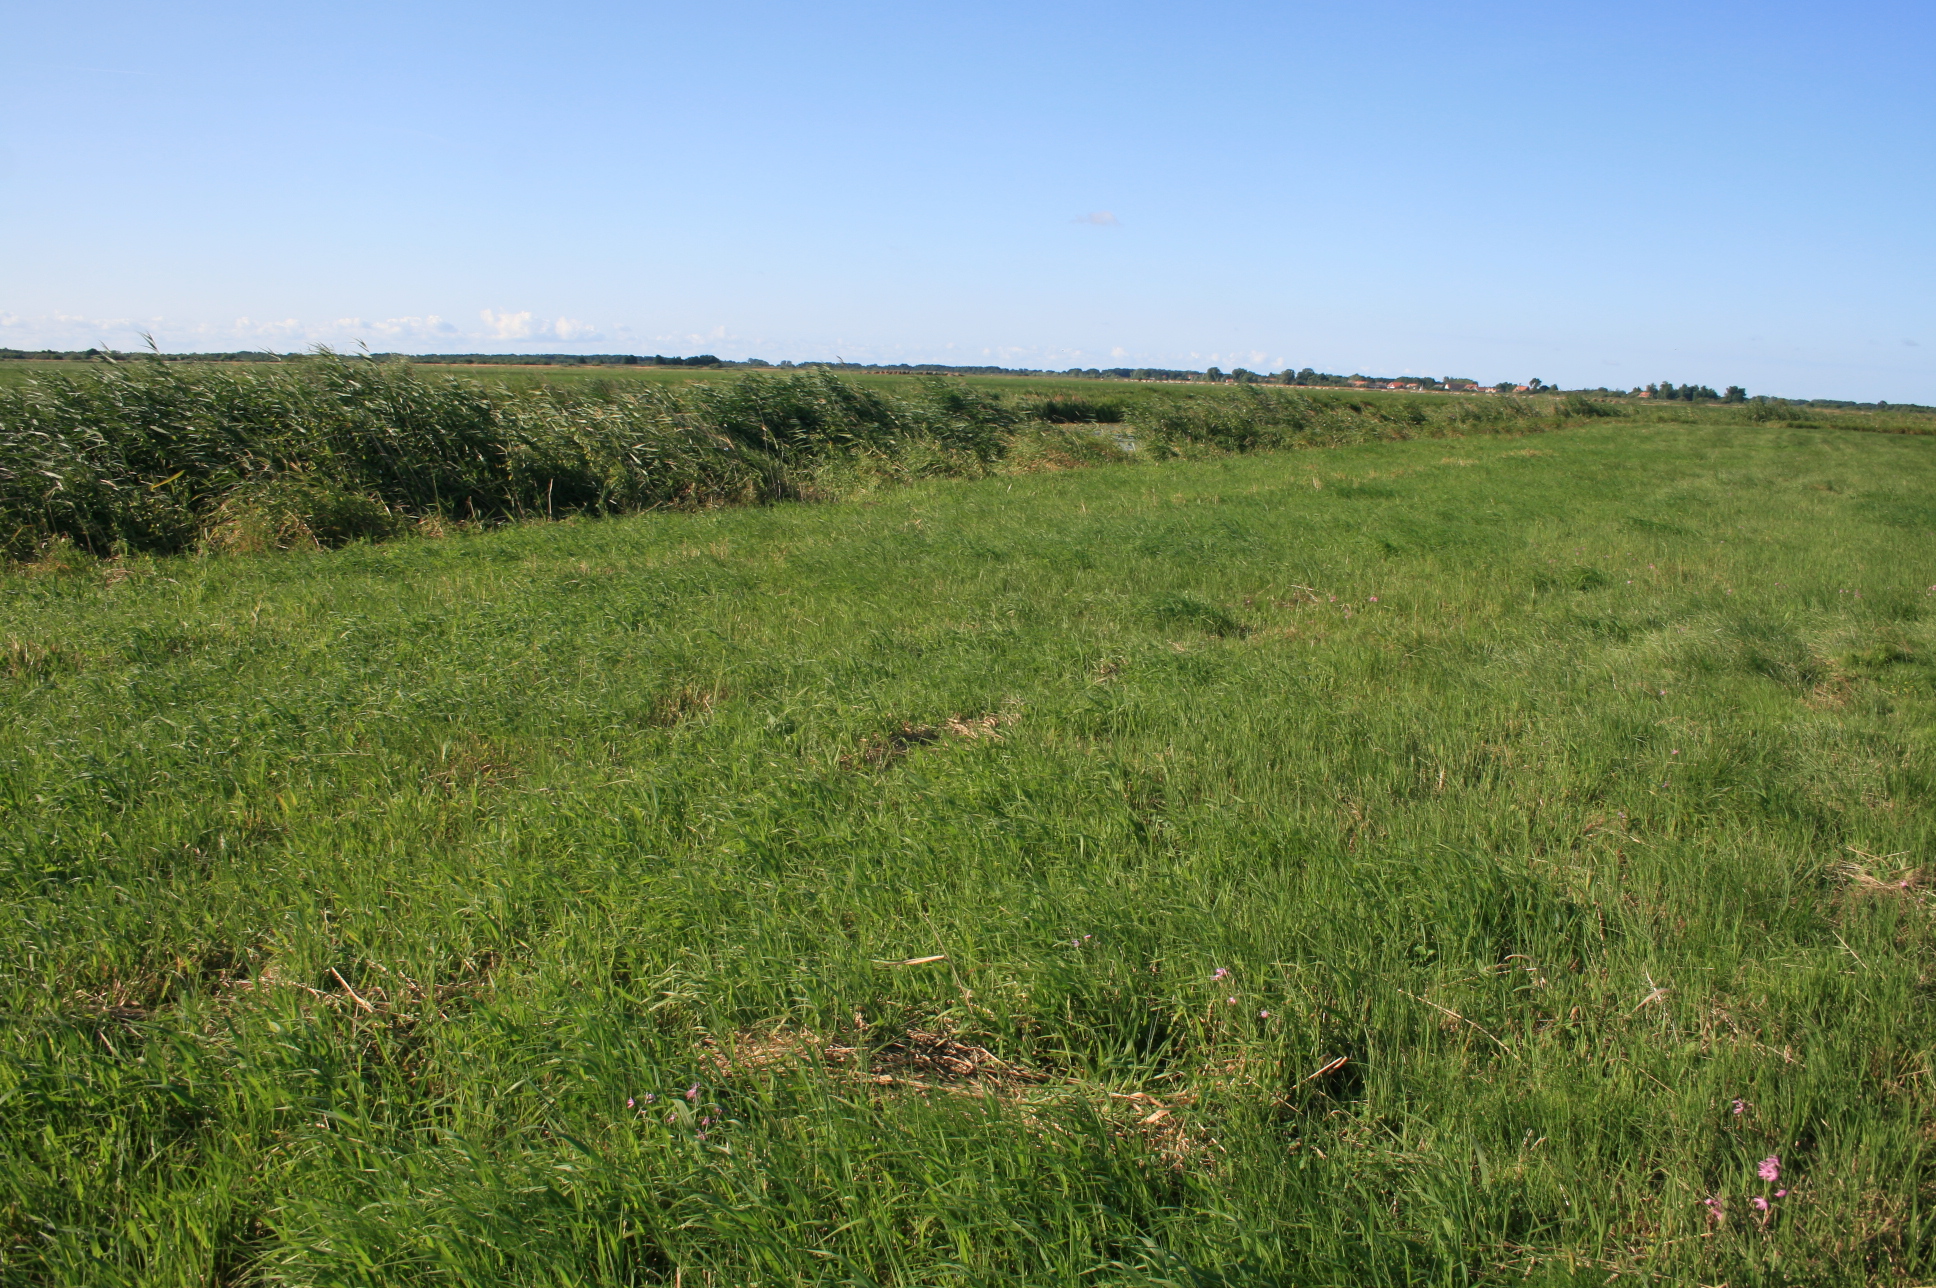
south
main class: Grassland
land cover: Grassland without tree/shrub cover
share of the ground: > 75 %
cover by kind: herbaceous plants 100 %
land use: Agriculture (excluding fallow land and kitchen gardens)
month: July
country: LT
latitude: 55.3783
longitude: 21.2960
